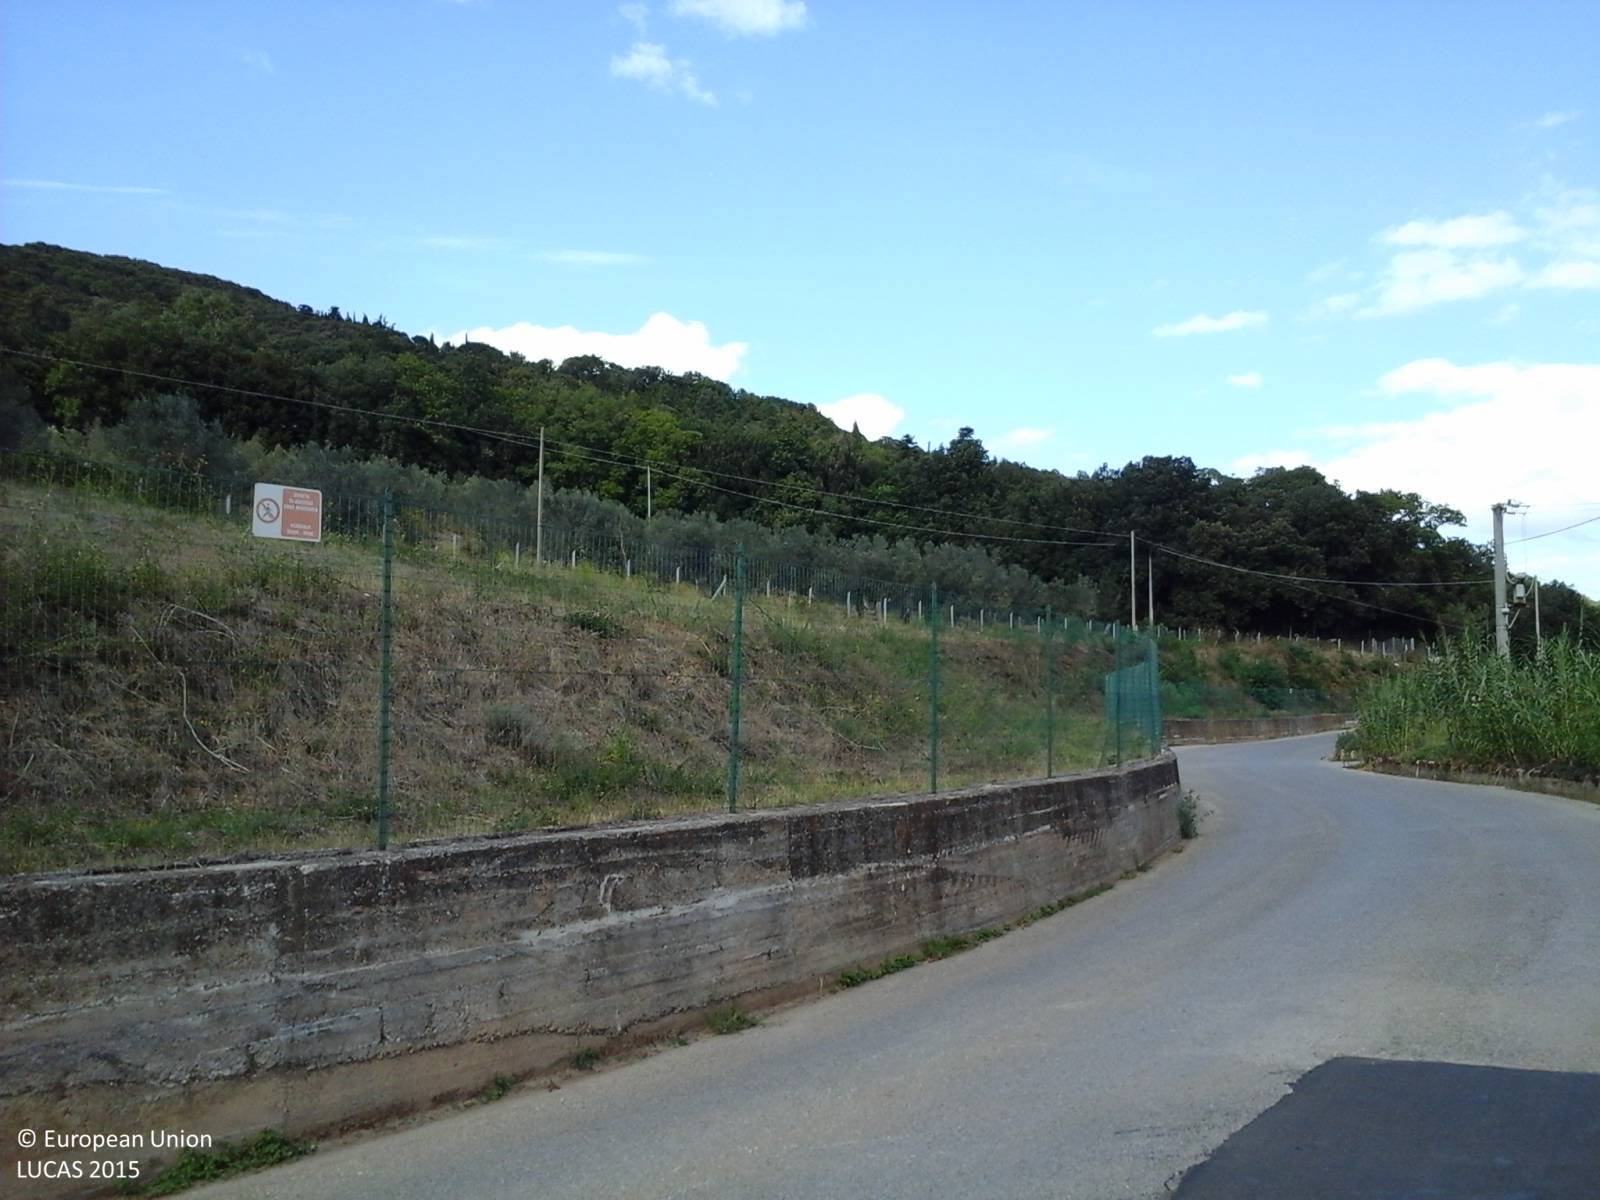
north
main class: Grassland
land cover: Grassland without tree/shrub cover
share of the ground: 50 - 75 %
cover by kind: herbaceous plants 100 %
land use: Agriculture (excluding fallow land and kitchen gardens)
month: September
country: IT
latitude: 43.0495
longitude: 10.5997
